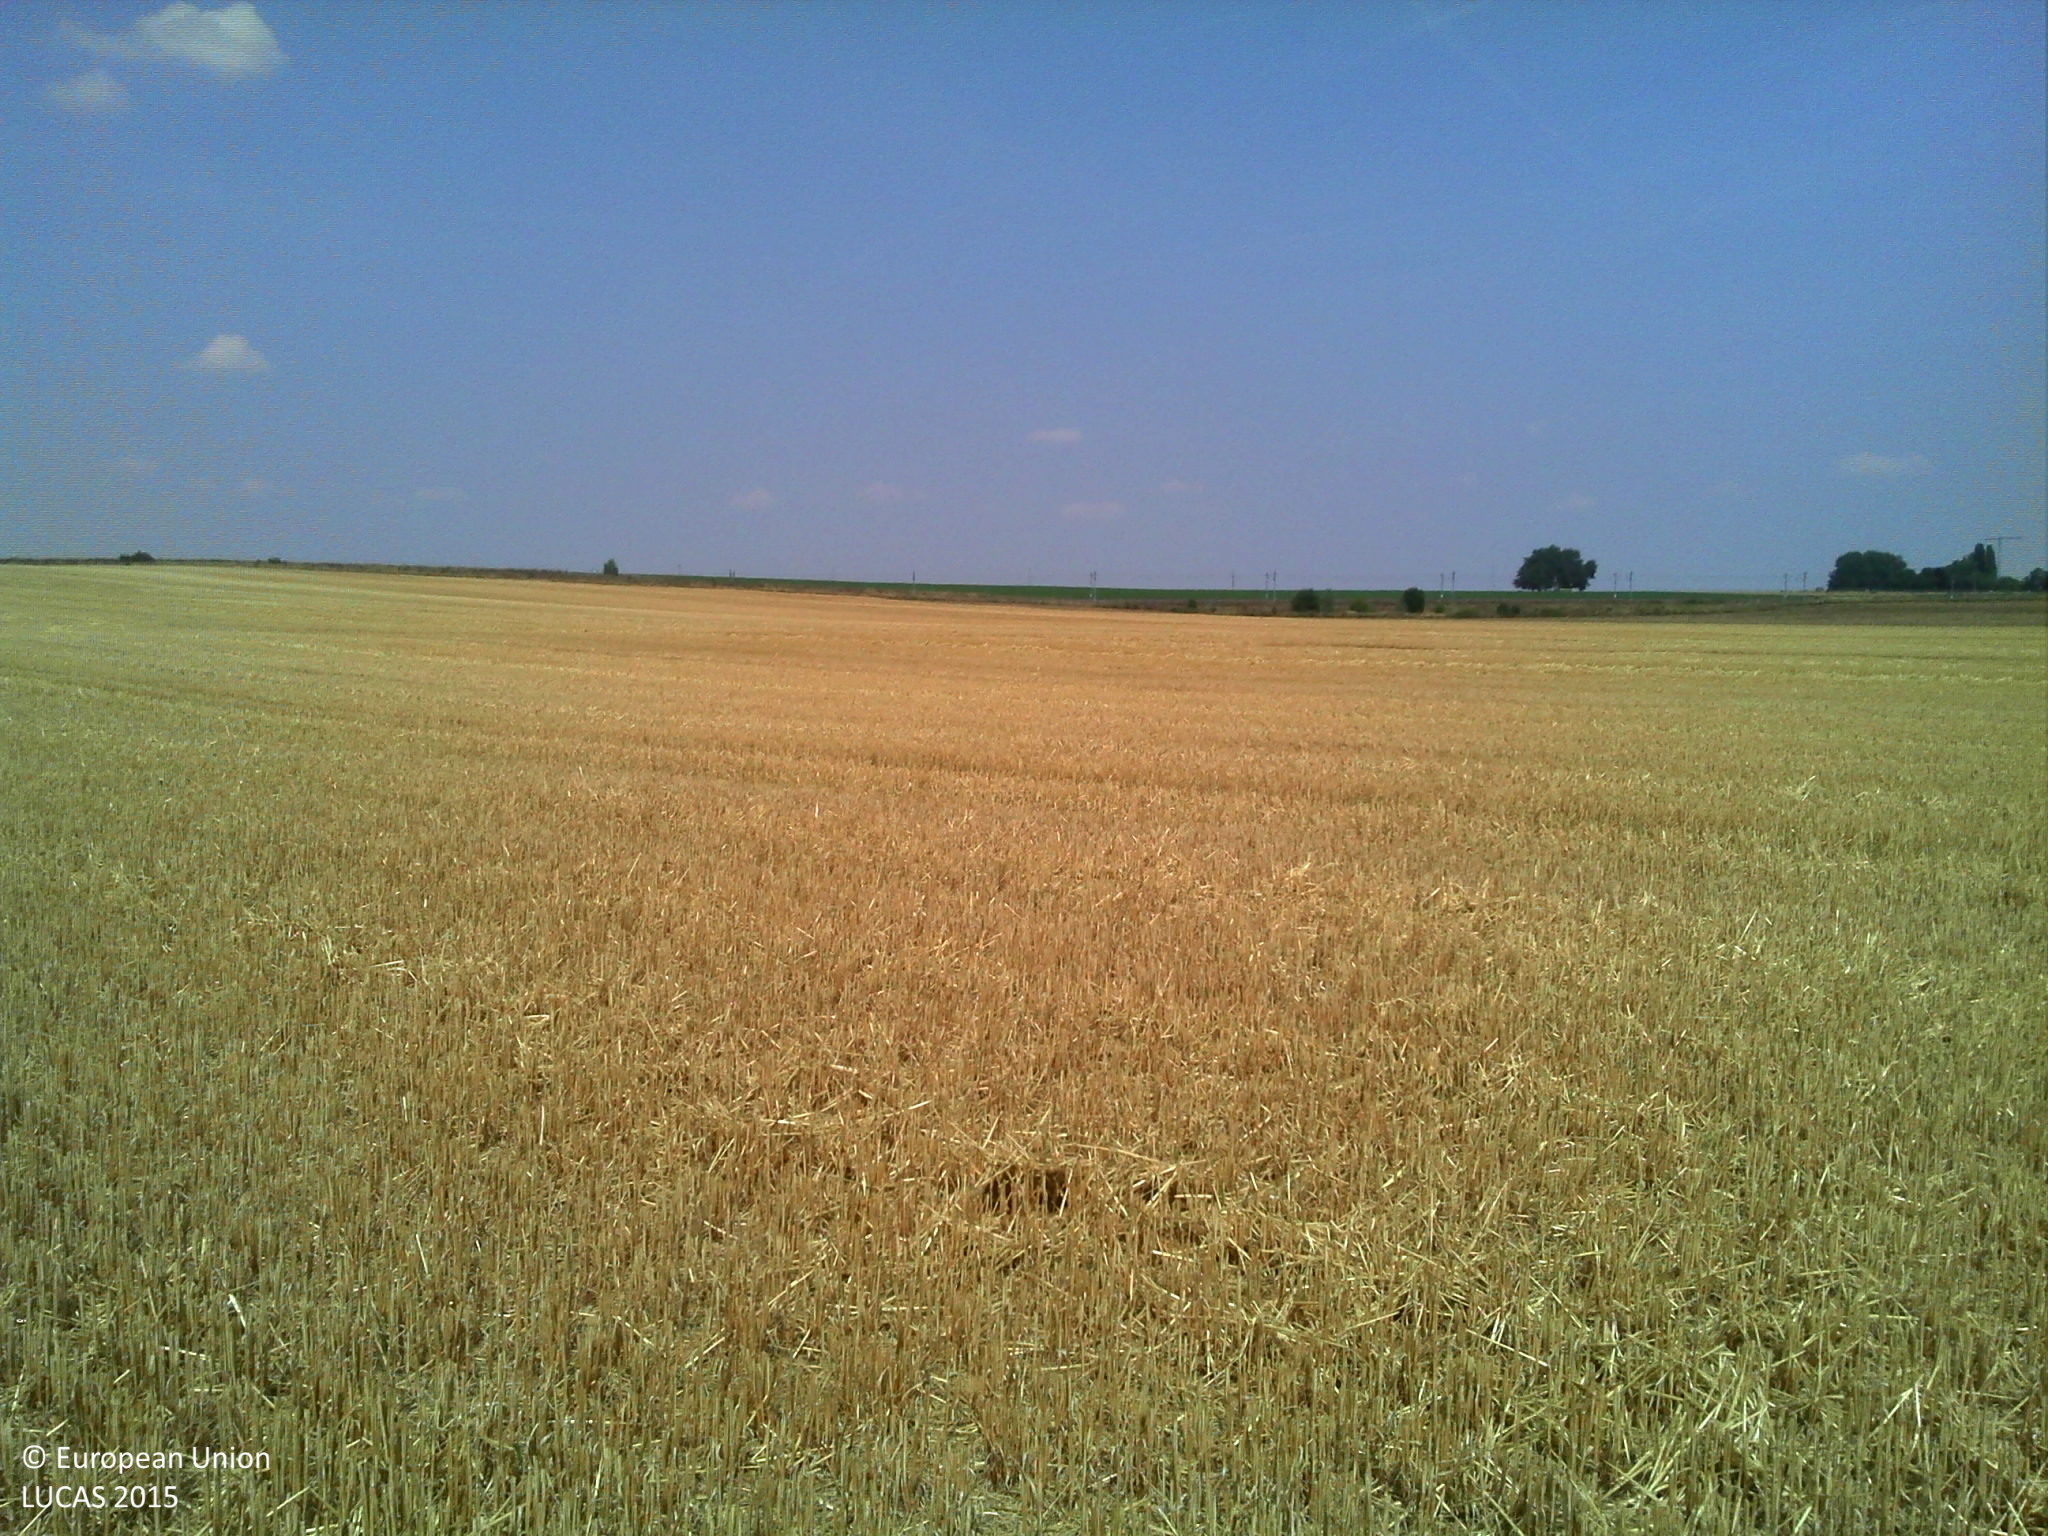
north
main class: Cropland
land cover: Triticale
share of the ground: > 75 %
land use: Agriculture (excluding fallow land and kitchen gardens)
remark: Harvested field
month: August
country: FR
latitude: 49.0056
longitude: 2.8957
